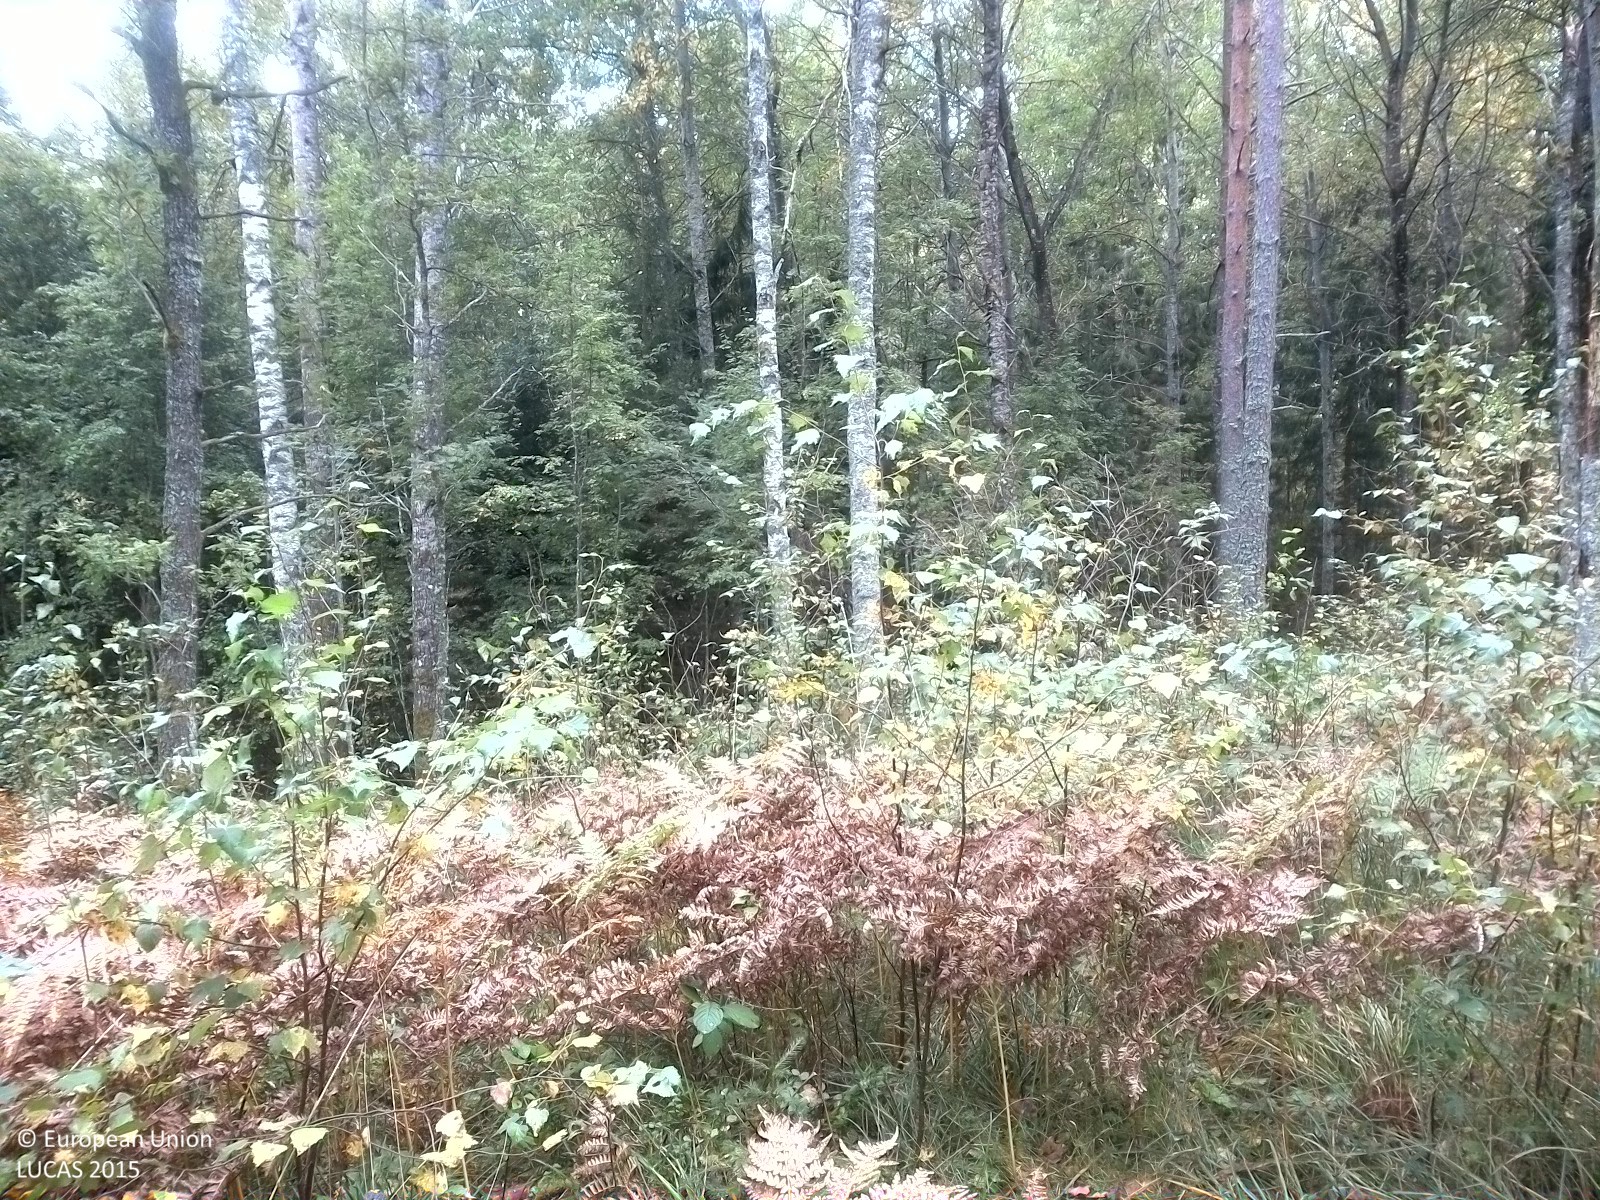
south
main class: Woodland
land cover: Pine dominated mixed woodland
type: boreal forest
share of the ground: 25 - 50 %
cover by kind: herbaceous plants 45 %, coniferous forest trees 25 %, broadleaved forest trees 15 %, shrubs 10 %, lichens and mosses 5 %
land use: Forestry
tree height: > 5 m
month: September
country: SE
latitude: 58.9223
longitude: 15.8465
